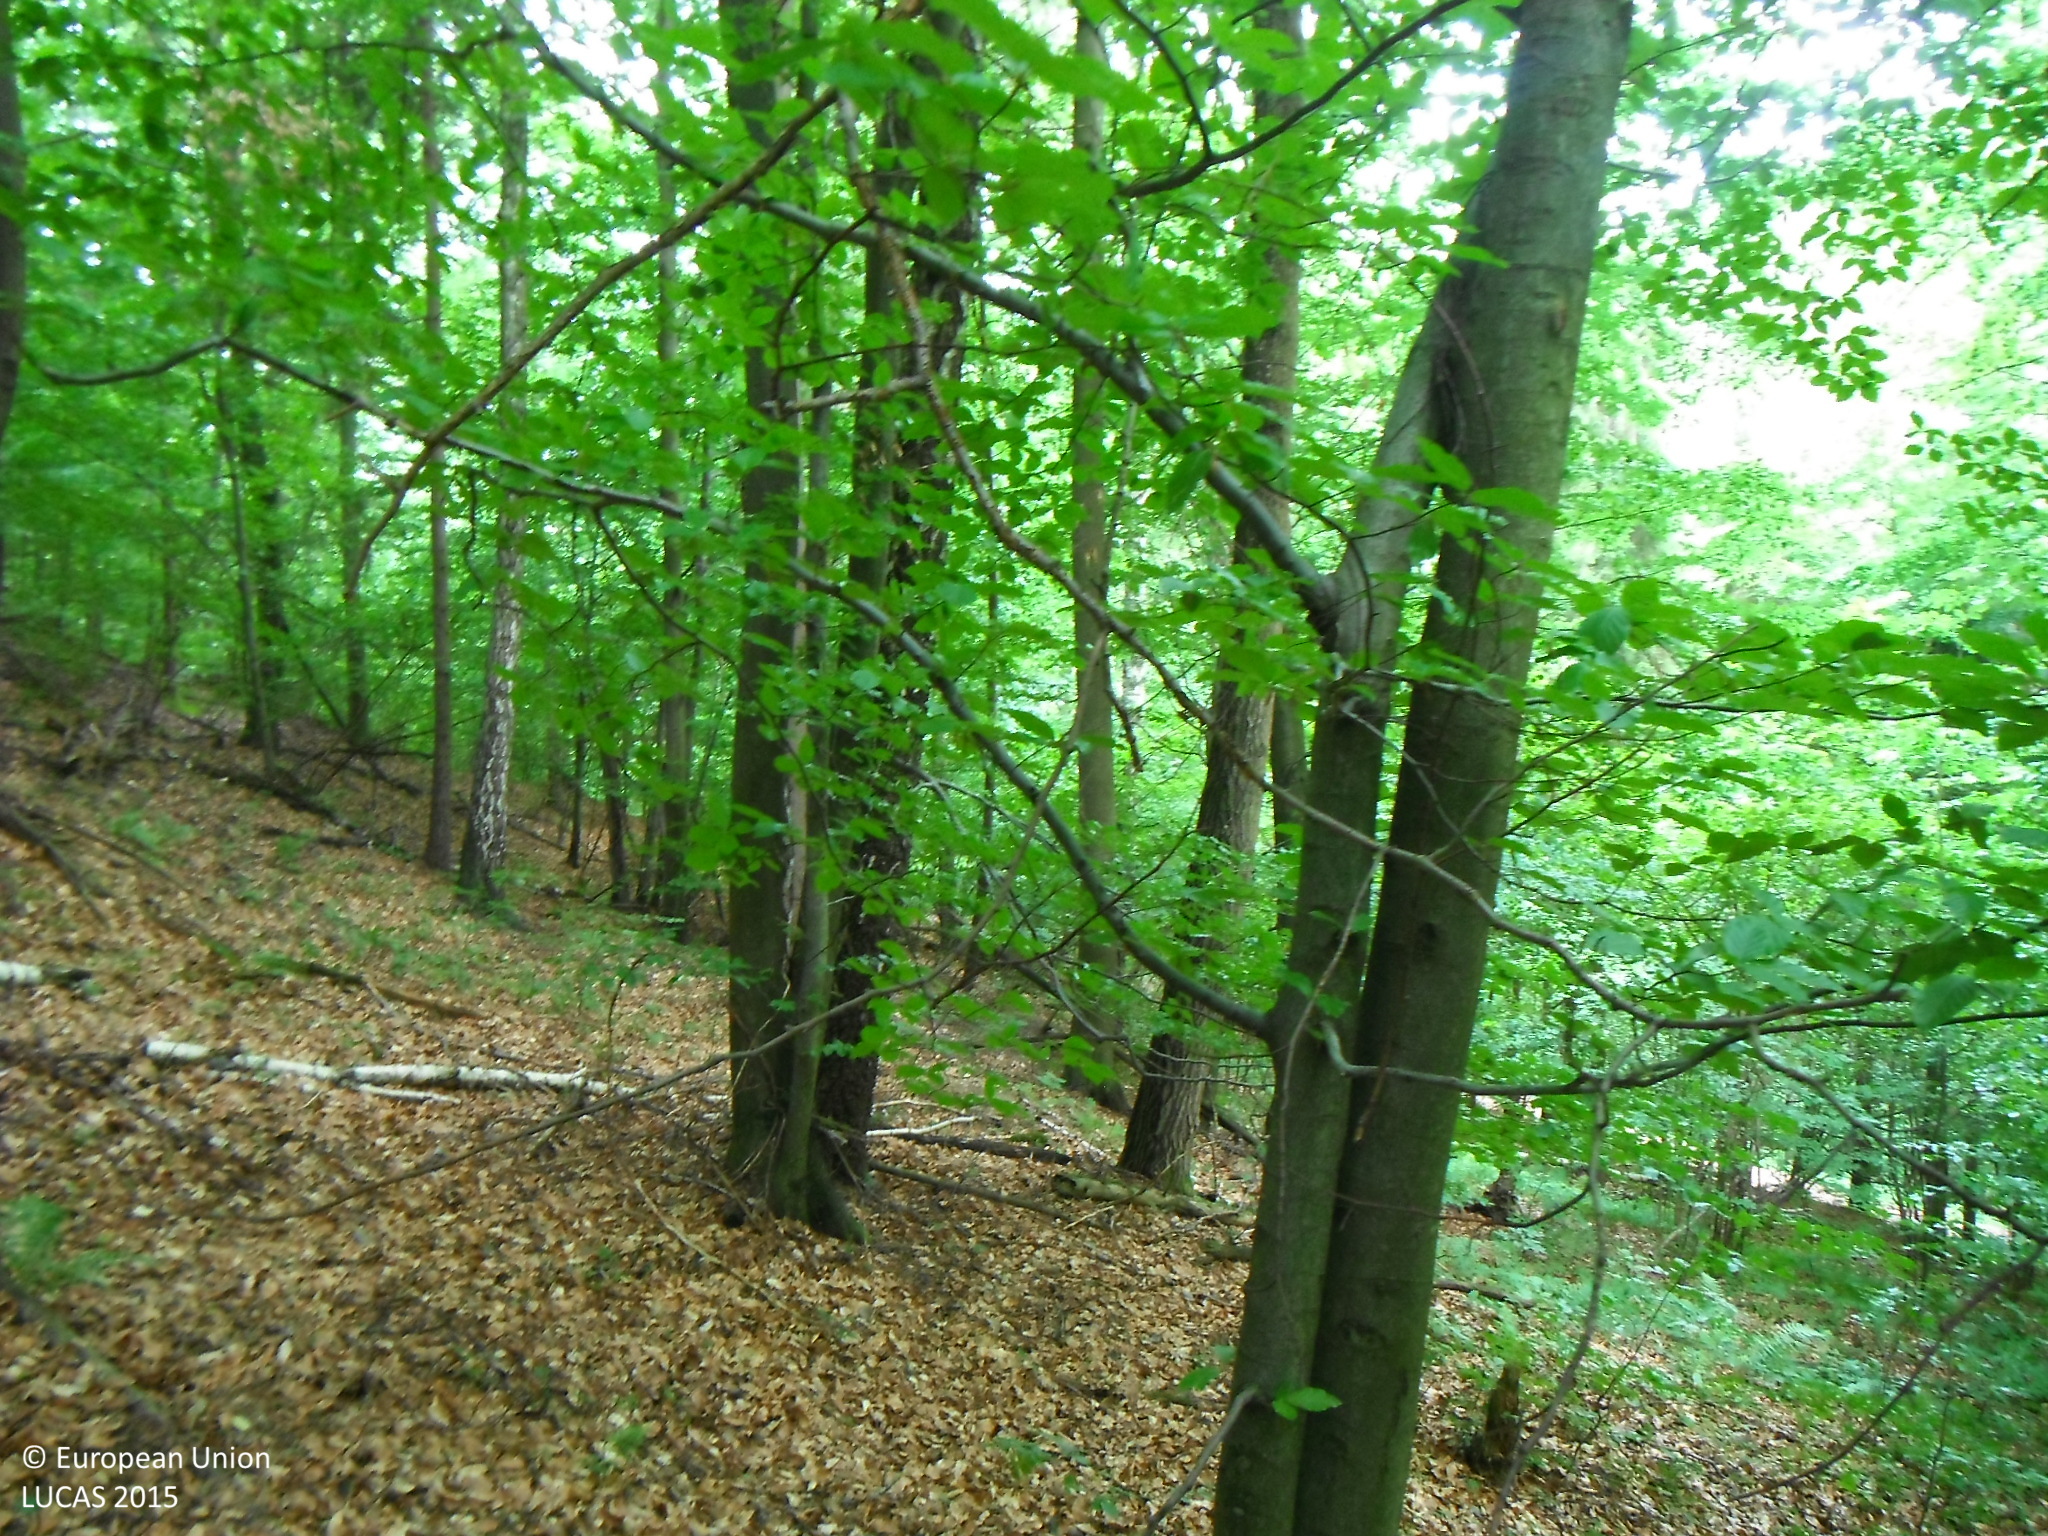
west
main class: Woodland
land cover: Broadleaved woodland
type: mesophytic deciduous forest
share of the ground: > 75 %
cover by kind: broadleaved forest trees 90 %, coniferous forest trees 10 %
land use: Forestry
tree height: > 5 m
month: July
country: SK
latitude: 49.2009
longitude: 21.8428
